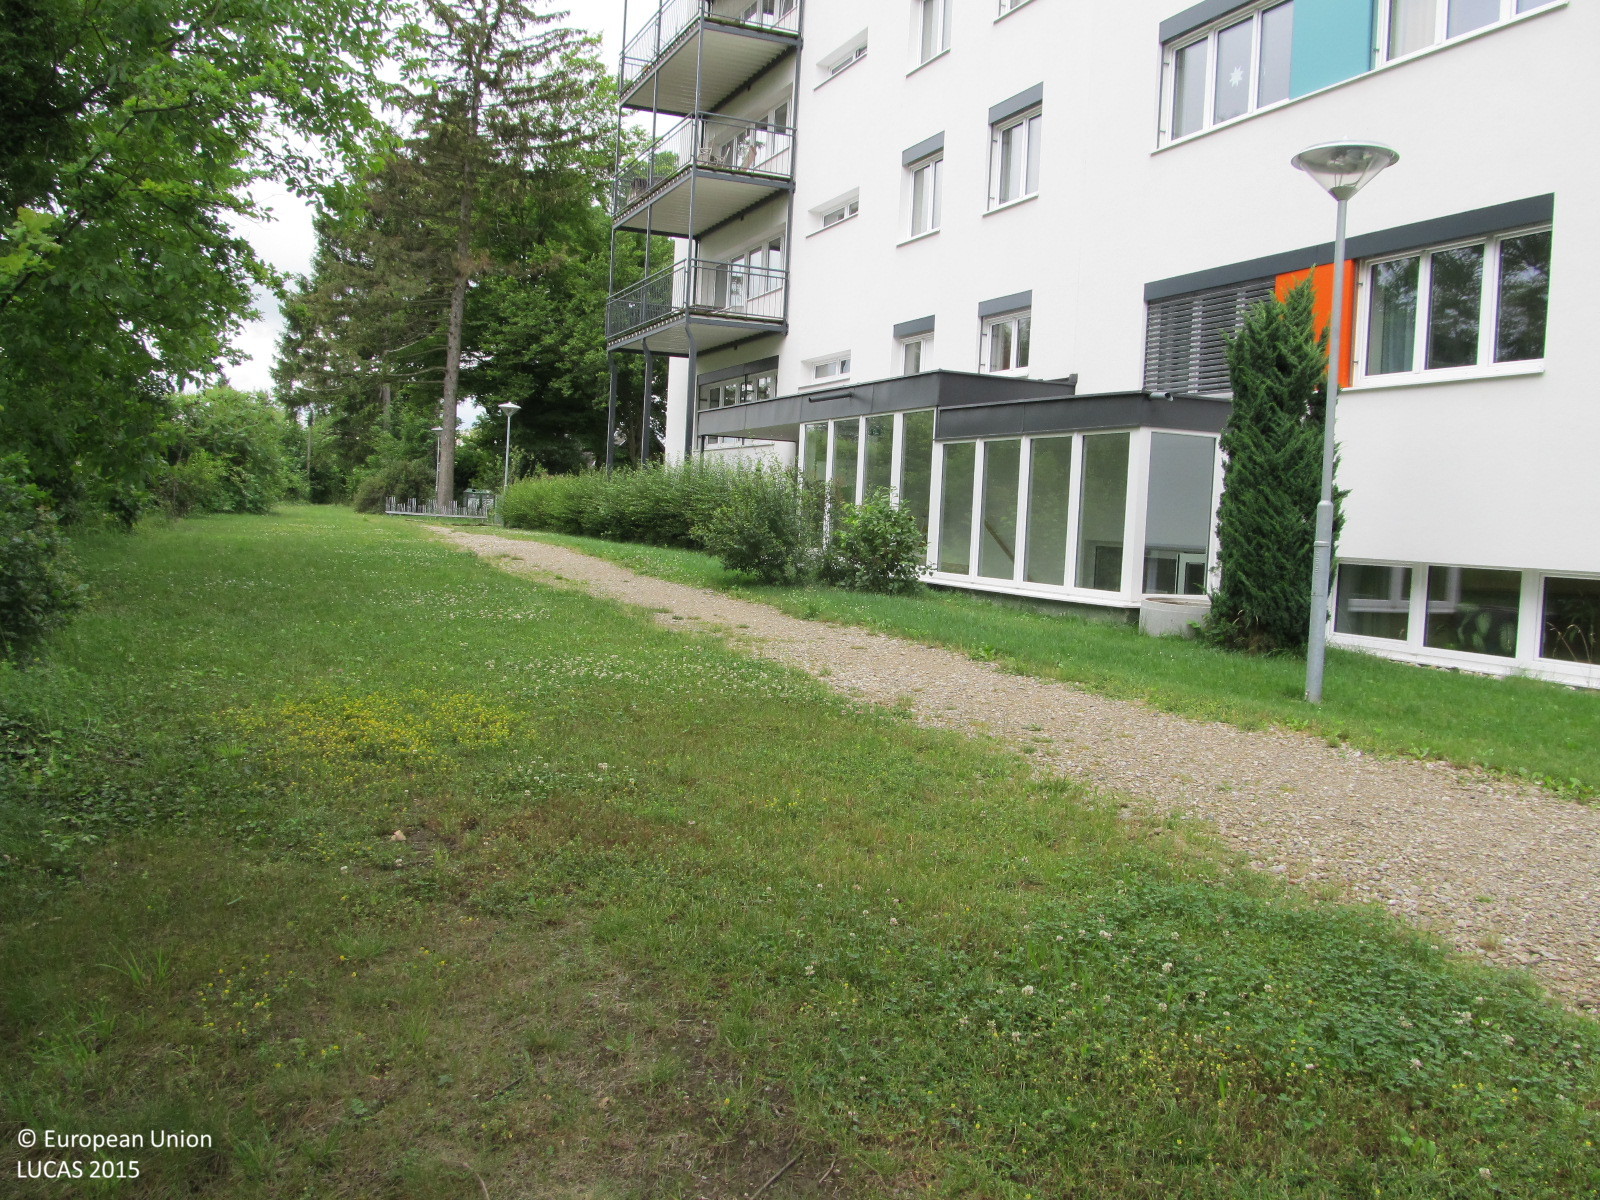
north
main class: Woodland
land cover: Broadleaved woodland
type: hemiboreal forest and nemoral coniferous forest and mixed broadleaved-coniferous forest
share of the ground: > 75 %
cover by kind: broadleaved forest trees 80 %, shrubs 20 %
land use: Forestry
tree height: < 5 m
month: June
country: AT
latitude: 48.2068
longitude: 15.6139
